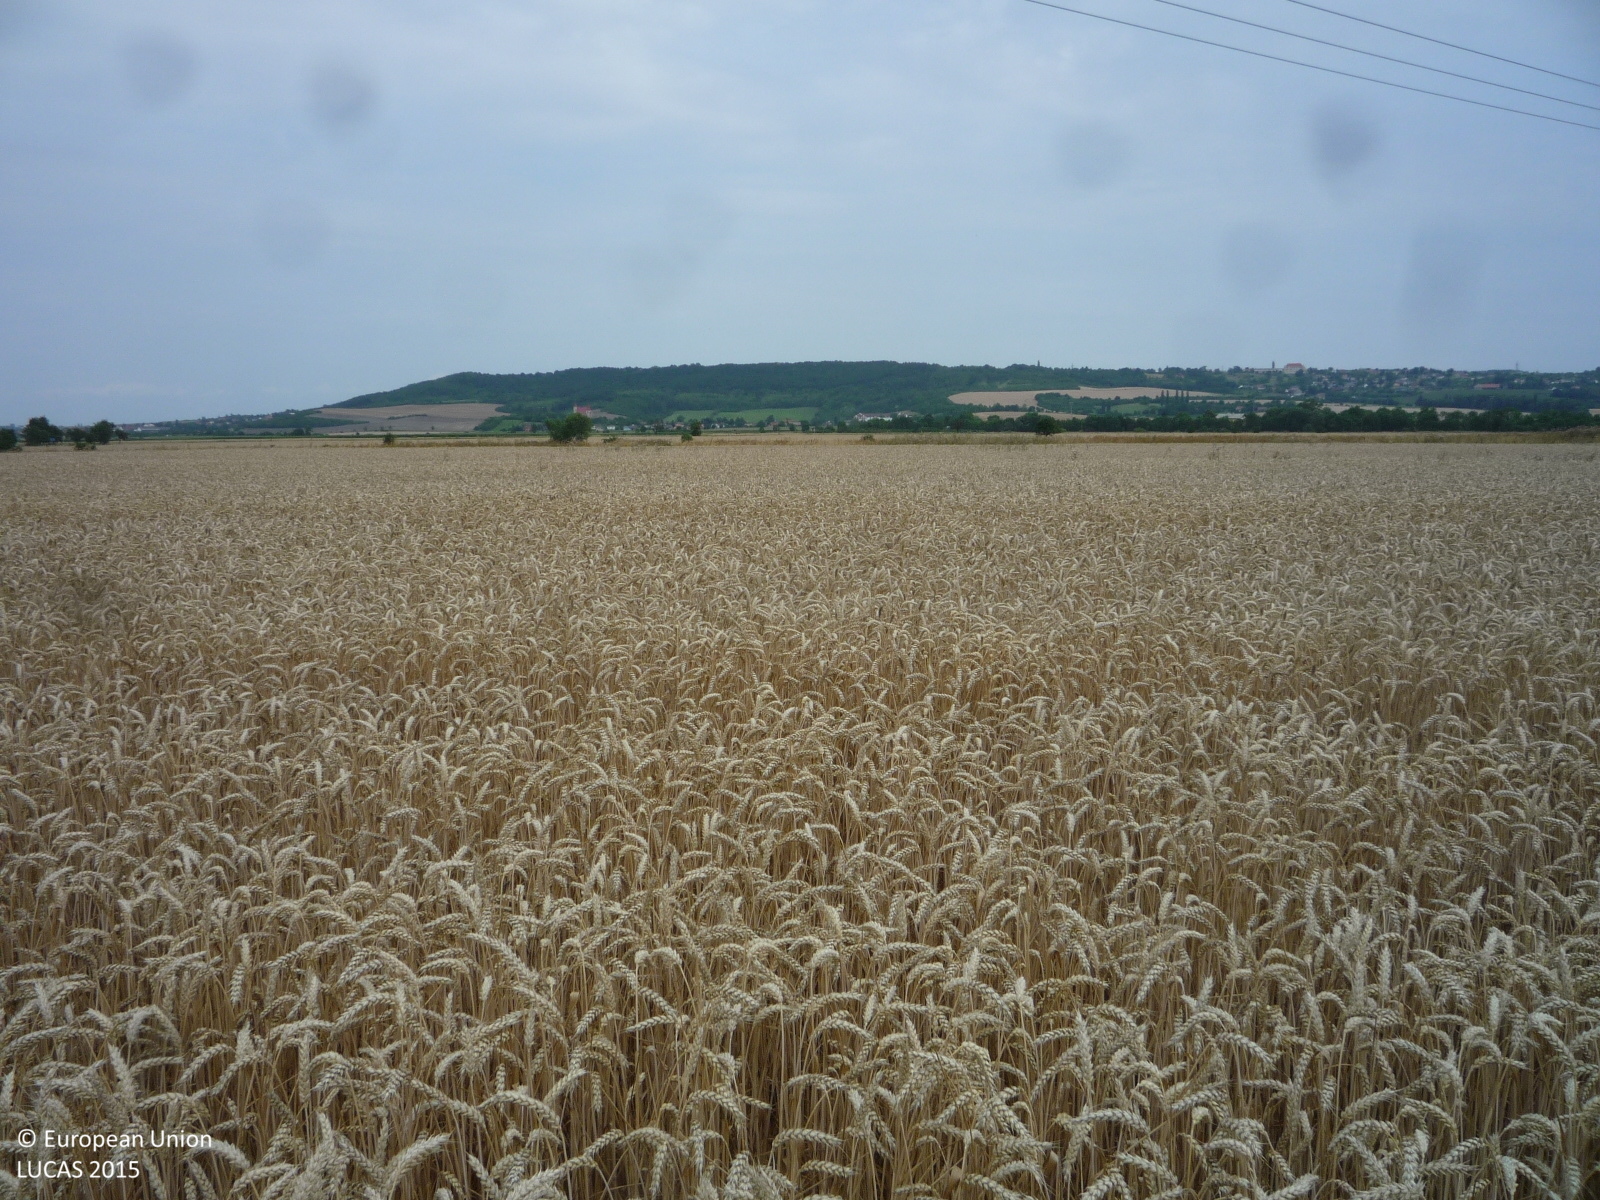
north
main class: Cropland
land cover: Common wheat
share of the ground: > 75 %
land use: Agriculture (excluding fallow land and kitchen gardens)
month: July
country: CZ
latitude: 50.3477
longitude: 14.9353
